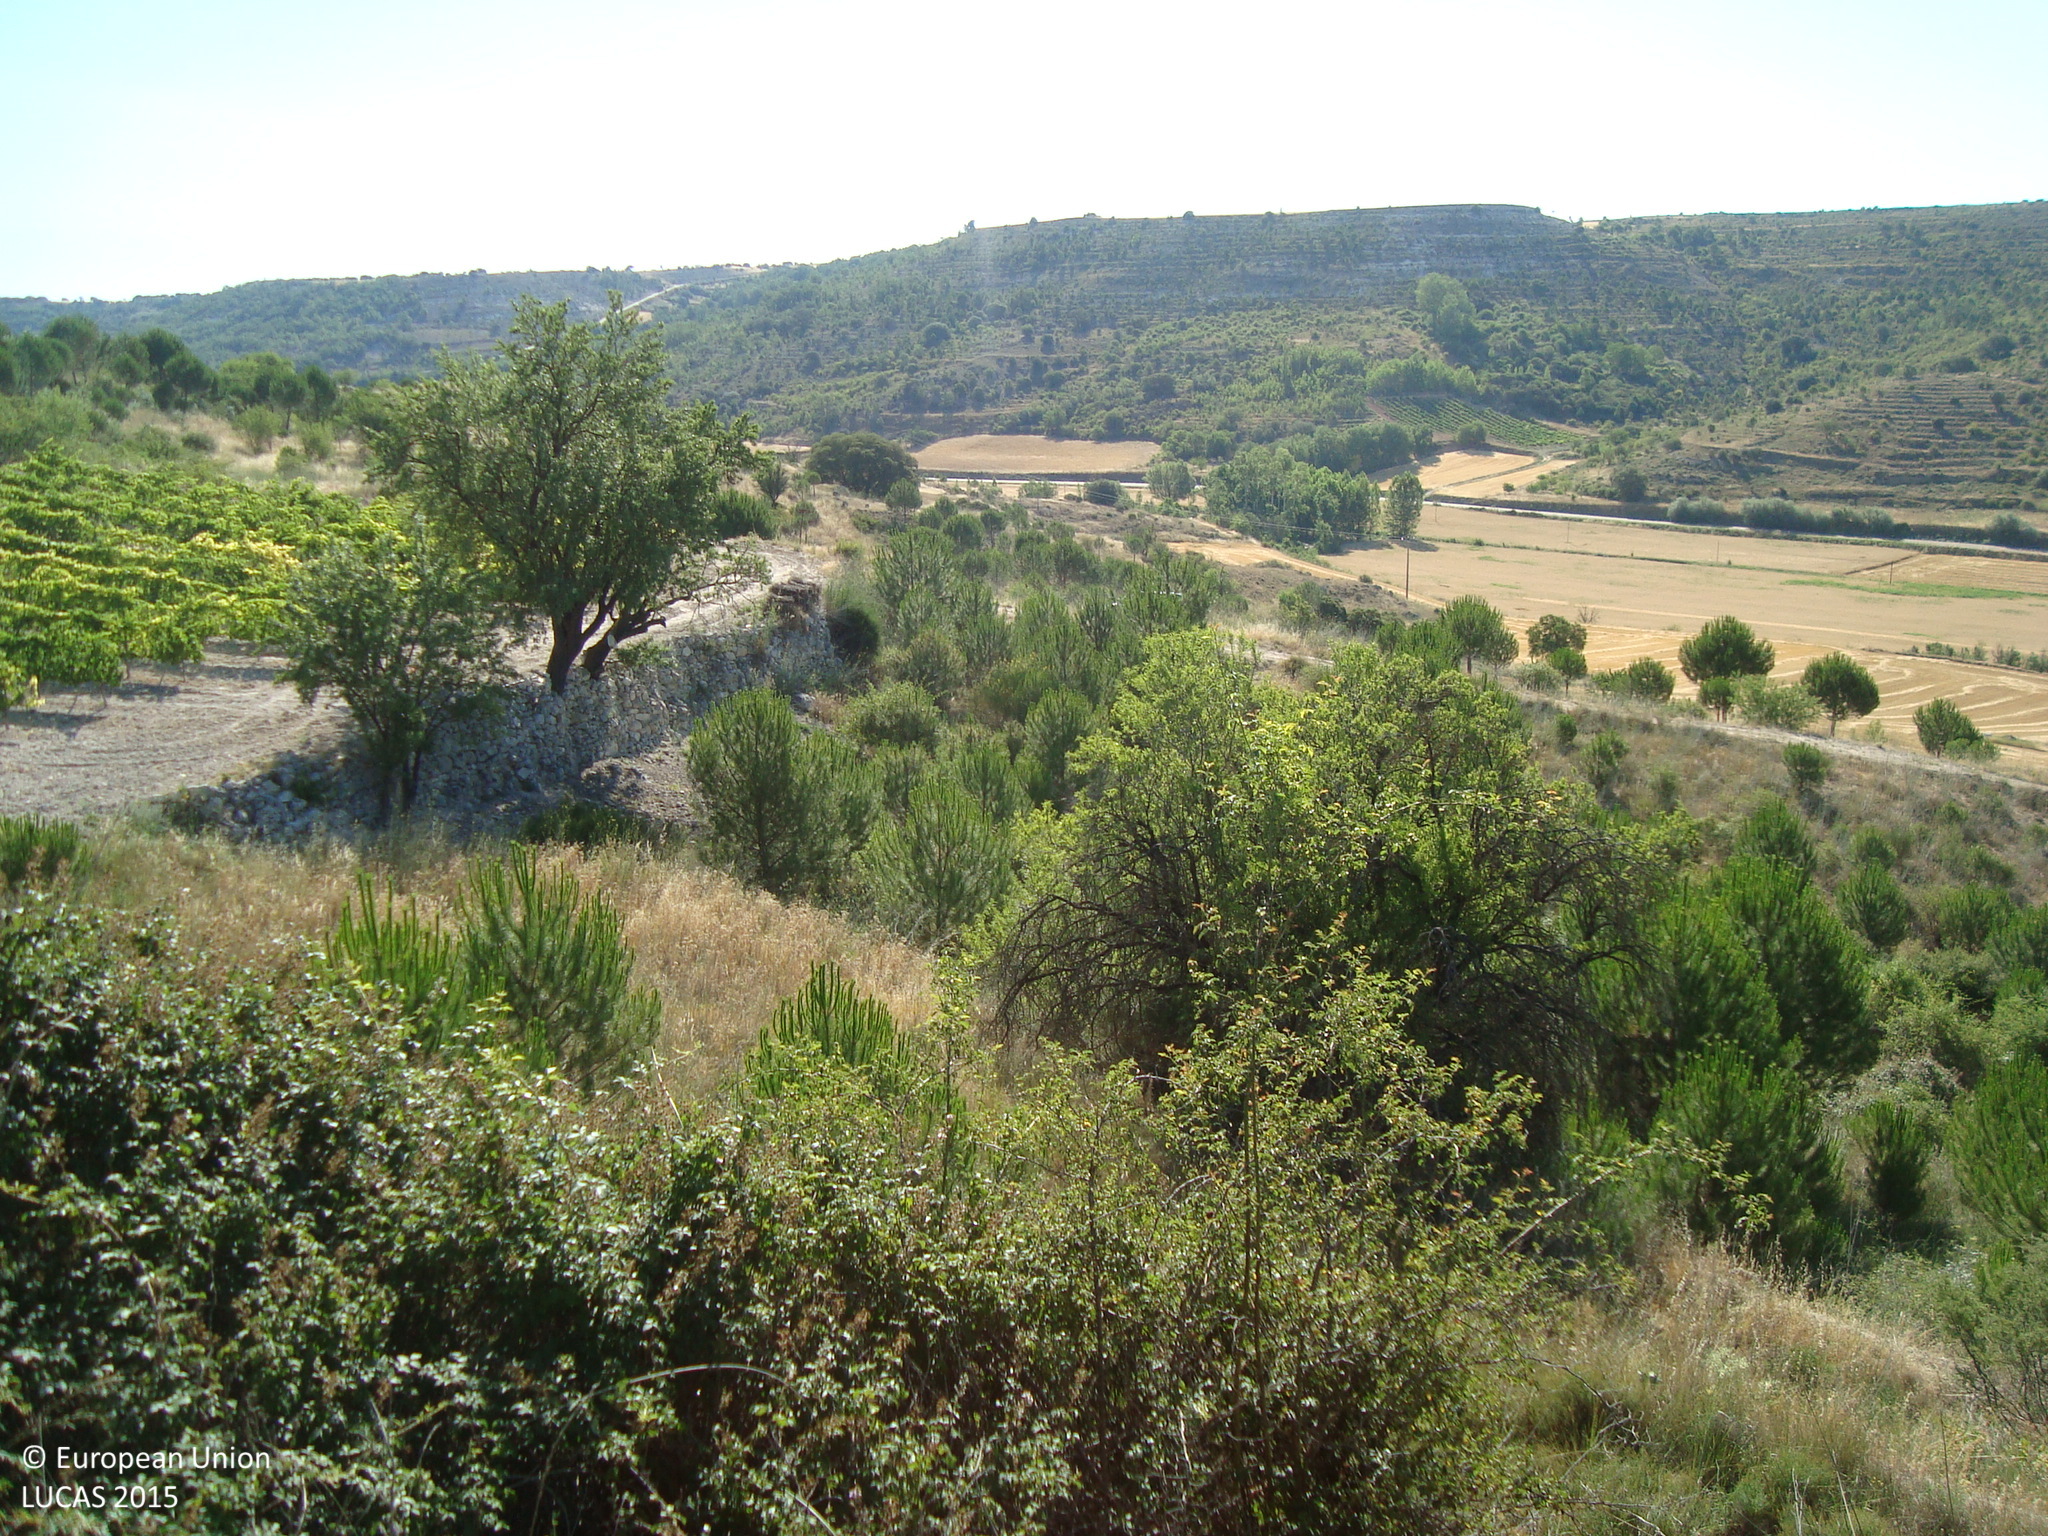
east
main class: Woodland
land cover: Pine dominated coniferous woodland
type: coniferous forest of the mediterranean region
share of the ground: 50 - 75 %
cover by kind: coniferous forest trees 60 %, shrubs 20 %, herbaceous plants 10 %, unconsolidated bare surface 10 %
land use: Forestry
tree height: > 5 m
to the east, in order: Pine dominated coniferous woodland; Tracks; Grassland without tree/shrub cover; Tracks; Grassland with sparse tree/shrub cover; Pine dominated coniferous woodland
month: July
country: ES
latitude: 41.6303
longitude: -4.0661
